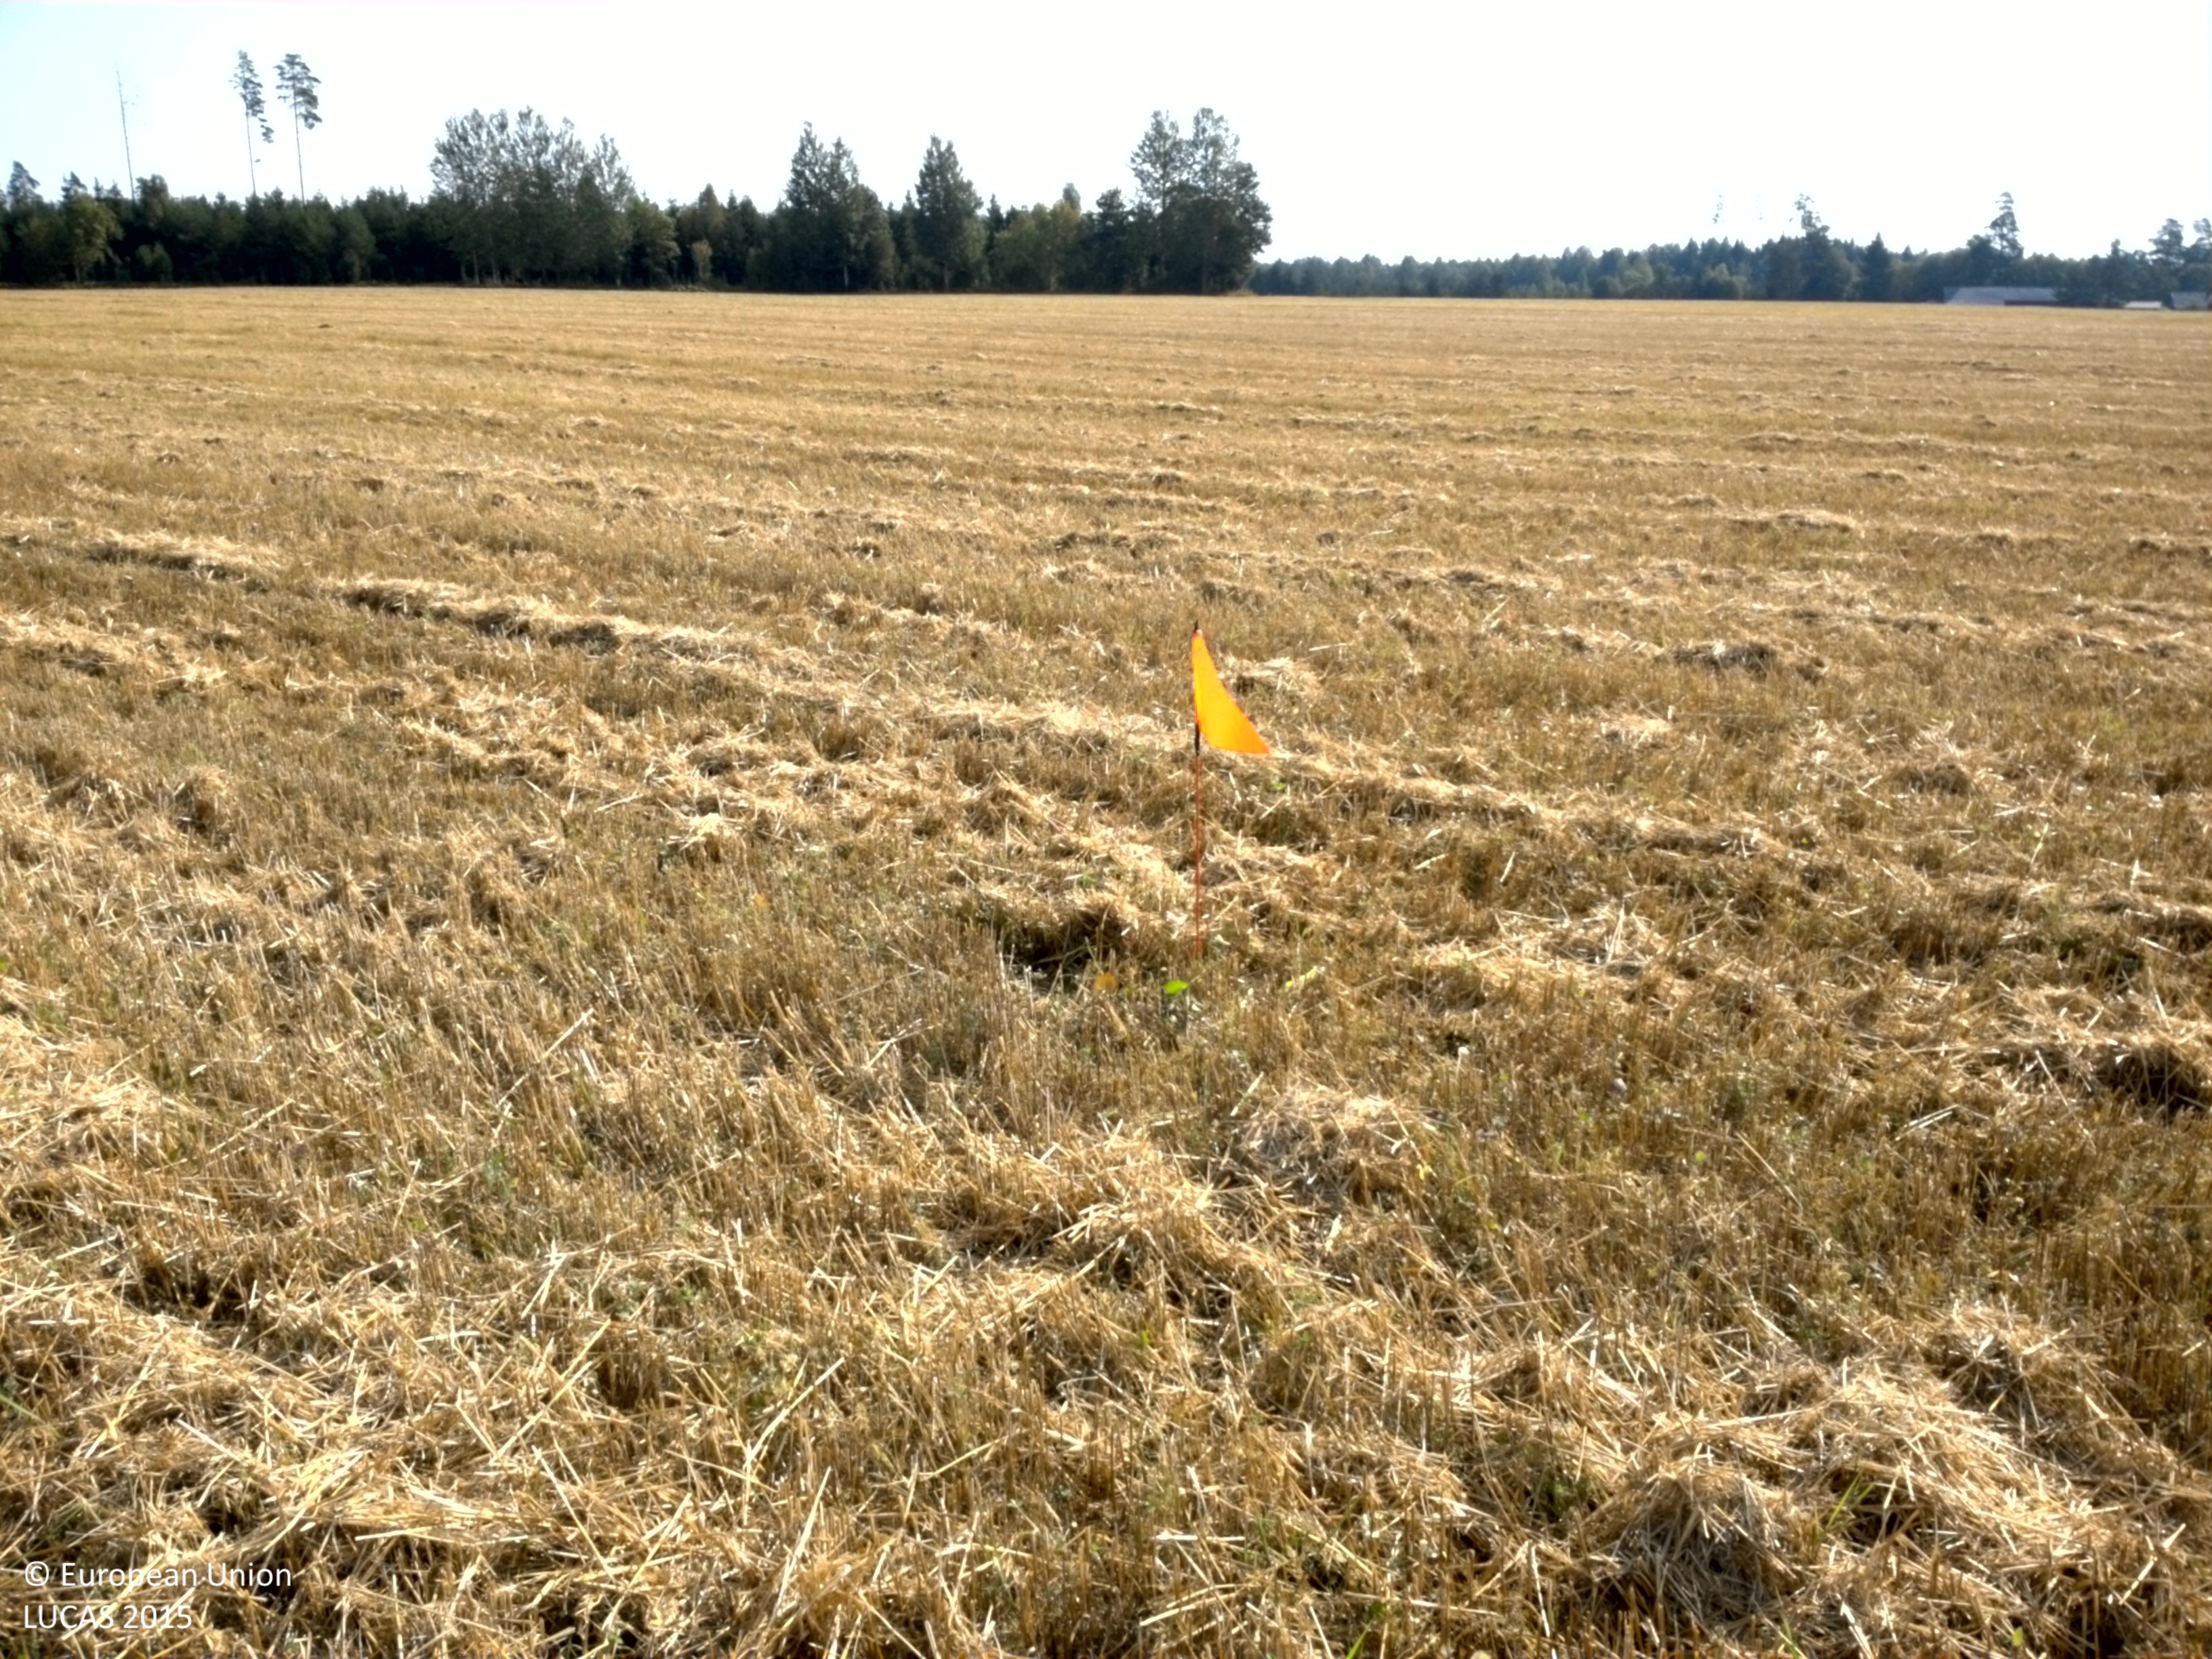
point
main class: Cropland
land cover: Barley
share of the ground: > 75 %
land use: Agriculture (excluding fallow land and kitchen gardens)
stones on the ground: < 10 %
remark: Harvested field
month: August
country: SE
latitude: 60.1061
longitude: 17.5297
